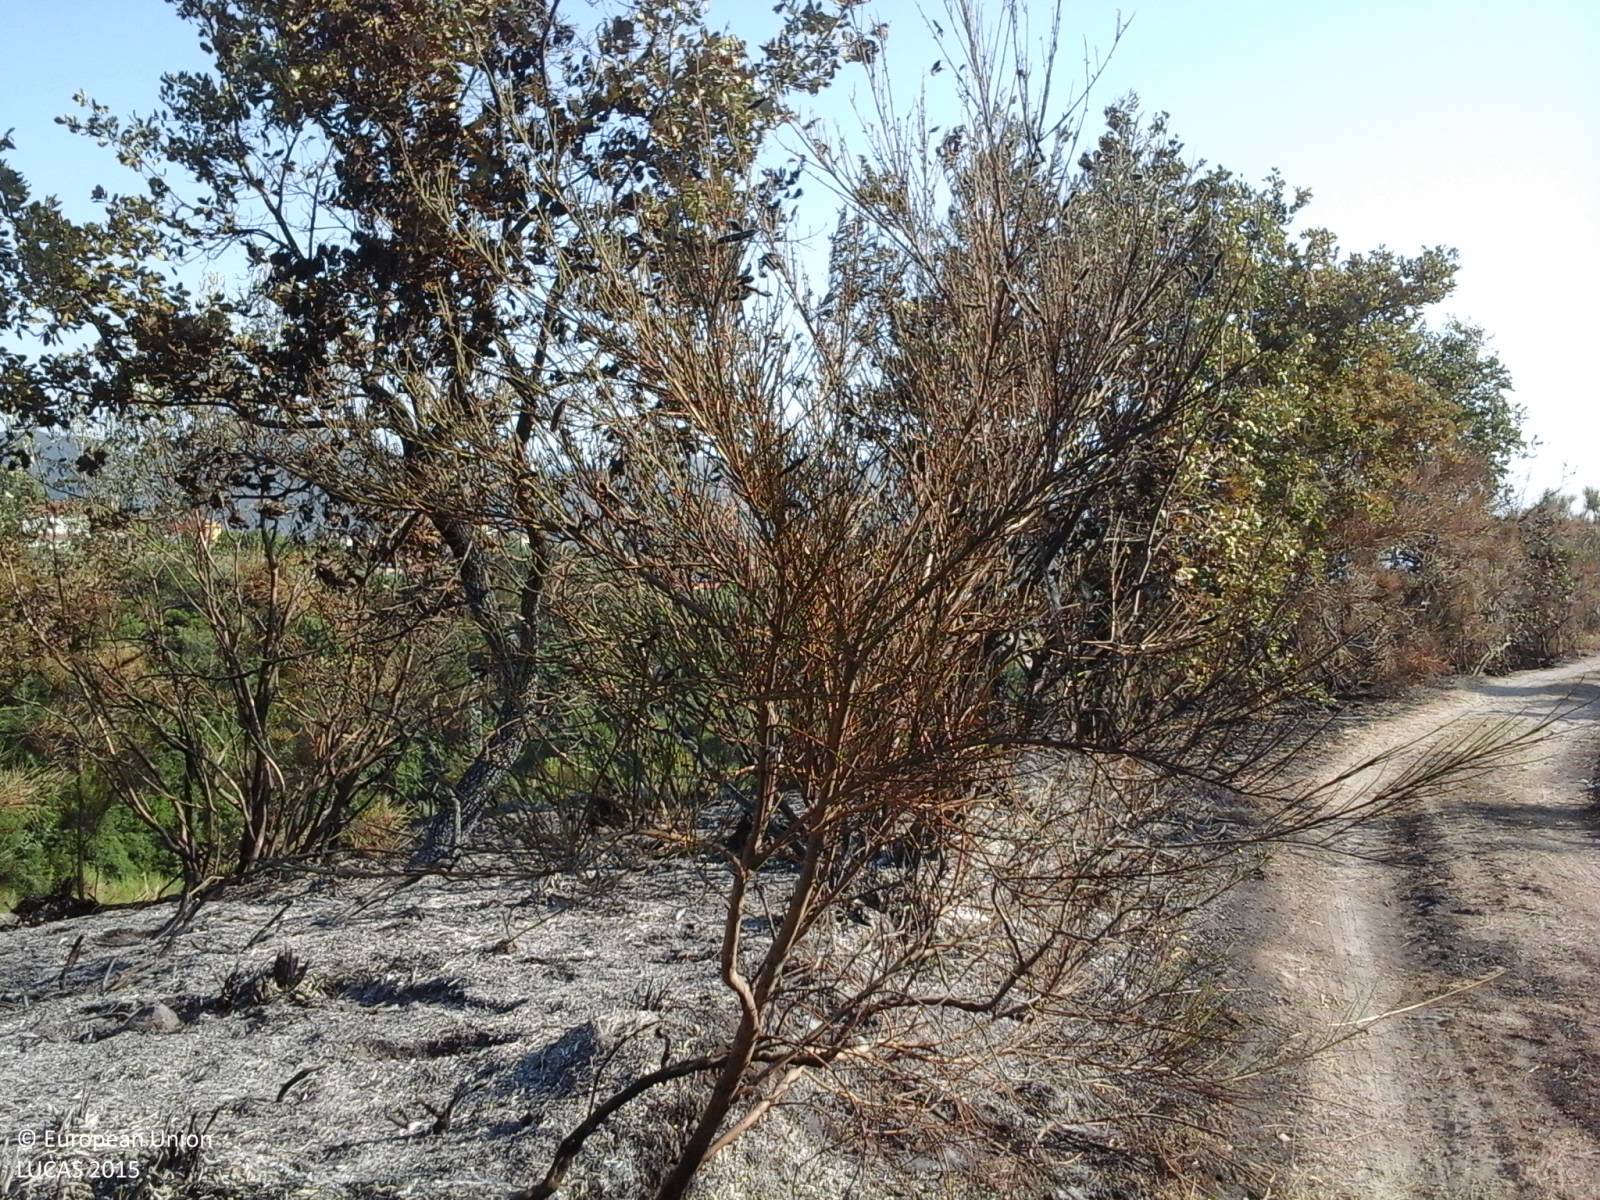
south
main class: Shrubland
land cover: Shrubland with sparse tree cover
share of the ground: 50 - 75 %
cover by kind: shrubs 95 %, broadleaved forest trees 5 %
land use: Abandoned areas
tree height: < 5 m
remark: Burnt area
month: July
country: IT
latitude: 41.2570
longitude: 13.9350
